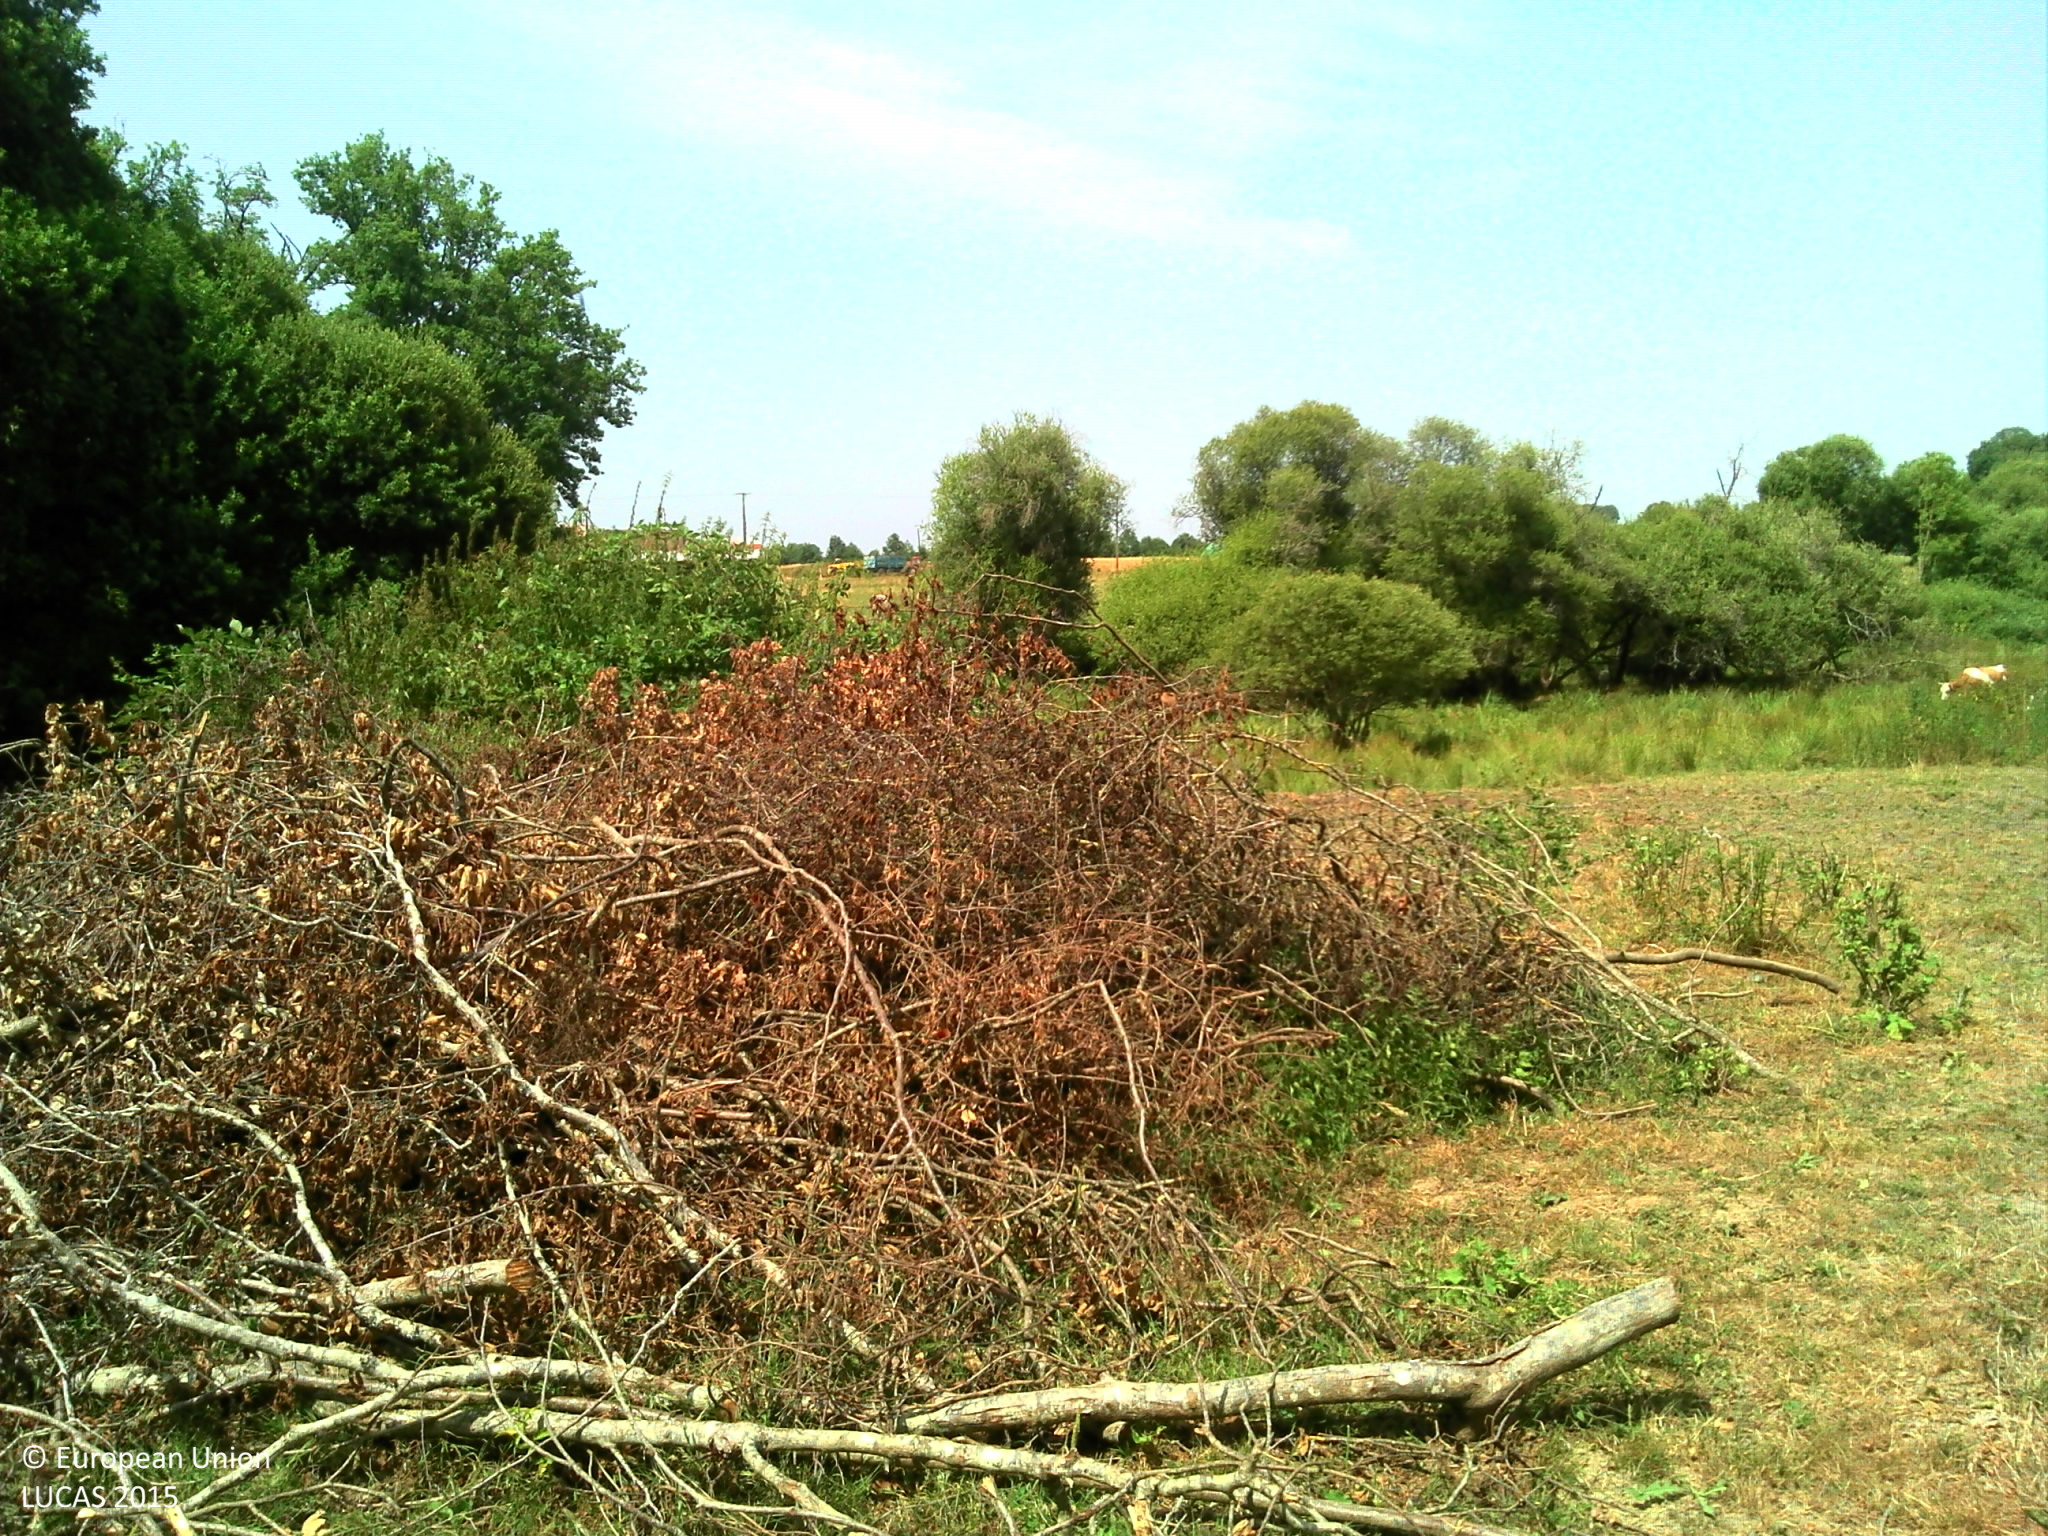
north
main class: Cropland
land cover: Maize
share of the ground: > 75 %
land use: Agriculture (excluding fallow land and kitchen gardens)
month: July
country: FR
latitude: 45.7204
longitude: 1.0348
